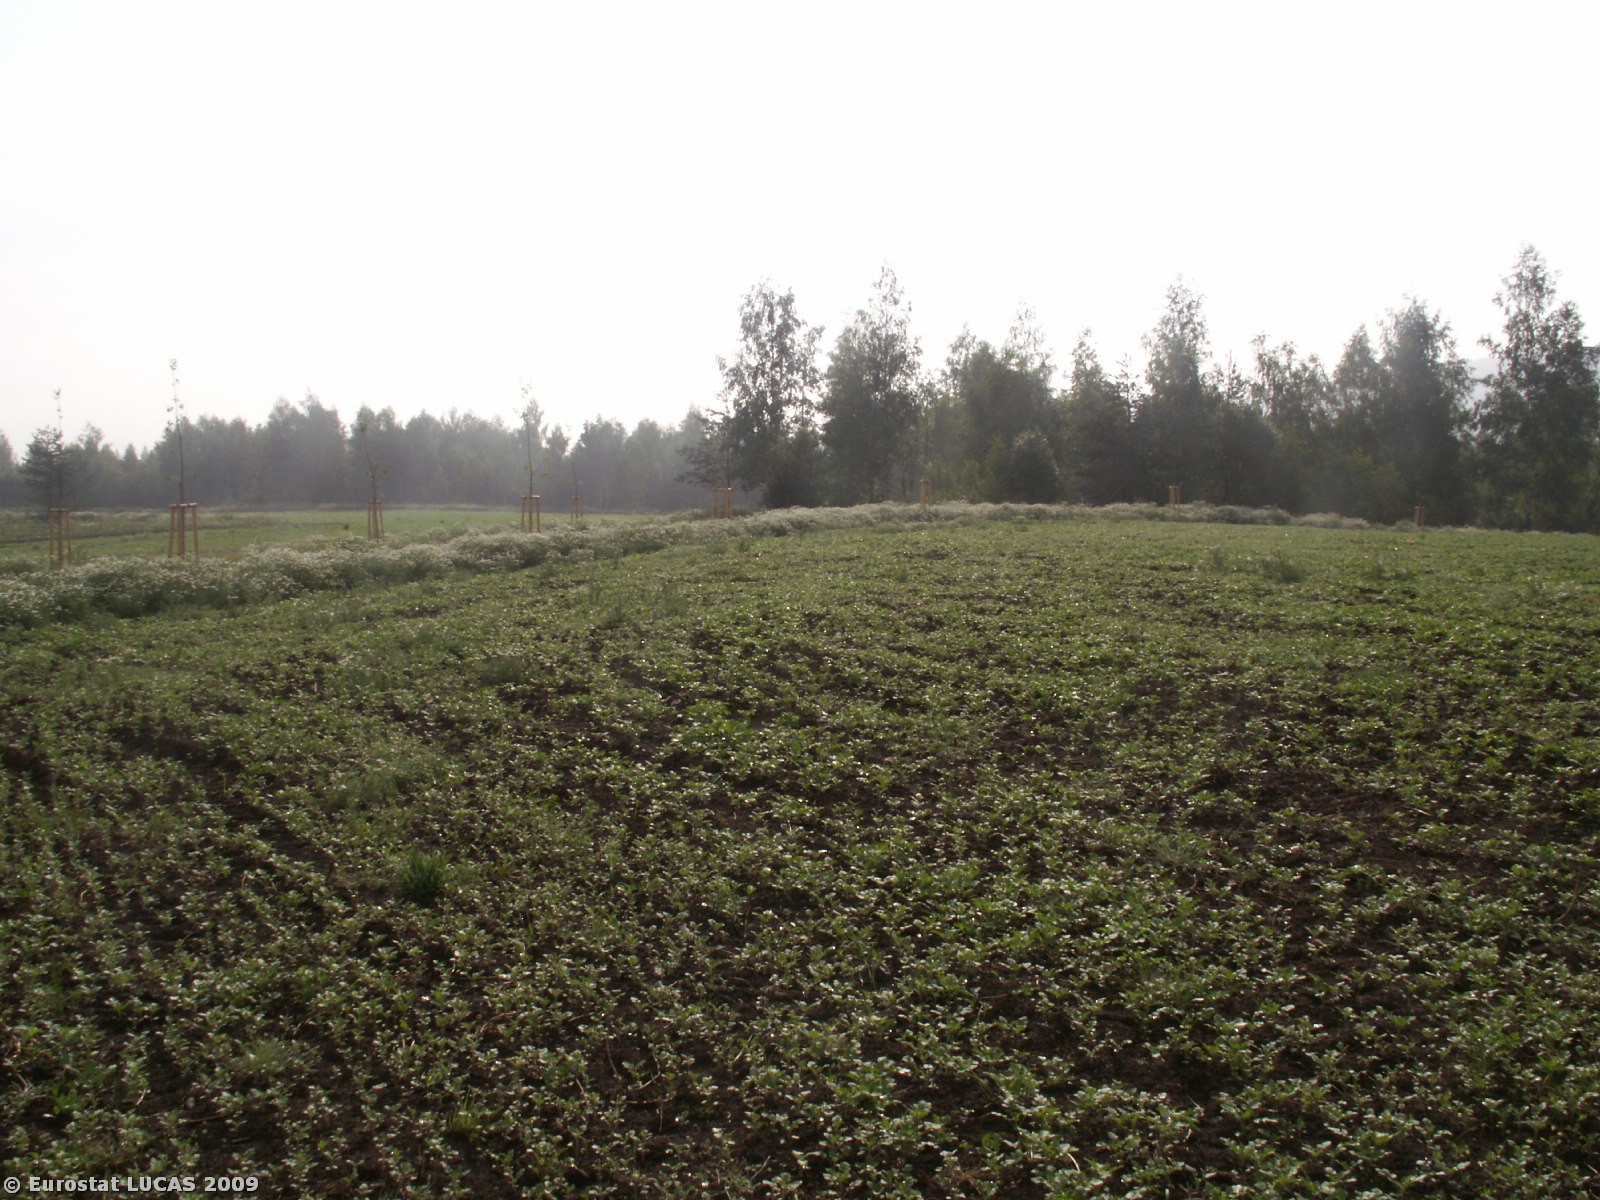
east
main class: Cropland
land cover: Other fibre and oleaginous crops
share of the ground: > 75 %
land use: Agriculture (excluding fallow land and kitchen gardens)
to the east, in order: Other fibre and oleaginous crops; Broadleaved woodland; Tracks; Broadleaved woodland; Tracks; Broadleaved woodland
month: July
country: CZ
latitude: 50.1536
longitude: 12.6450
